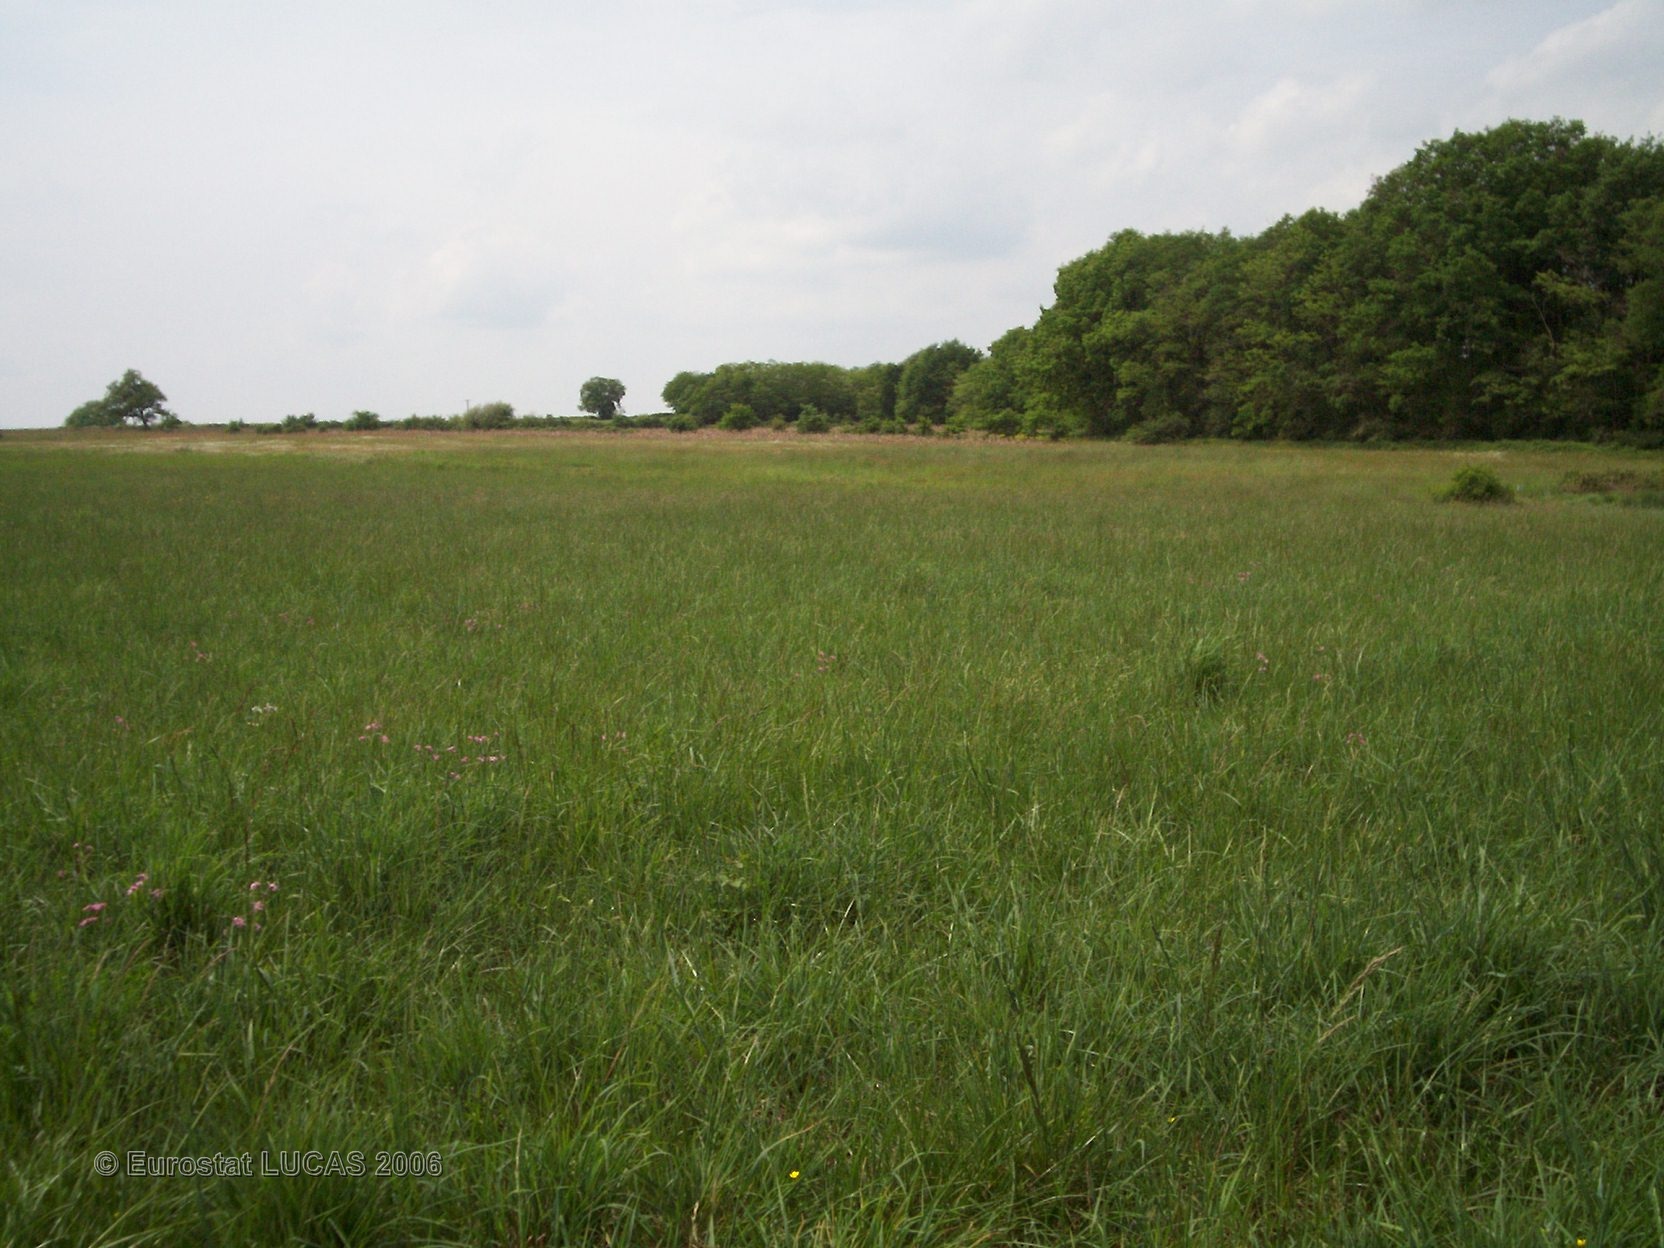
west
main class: Grassland
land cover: Grassland without tree/shrub cover
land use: Agriculture (excluding fallow land and kitchen gardens)
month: May
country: FR
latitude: 46.7338
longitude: 1.0214
